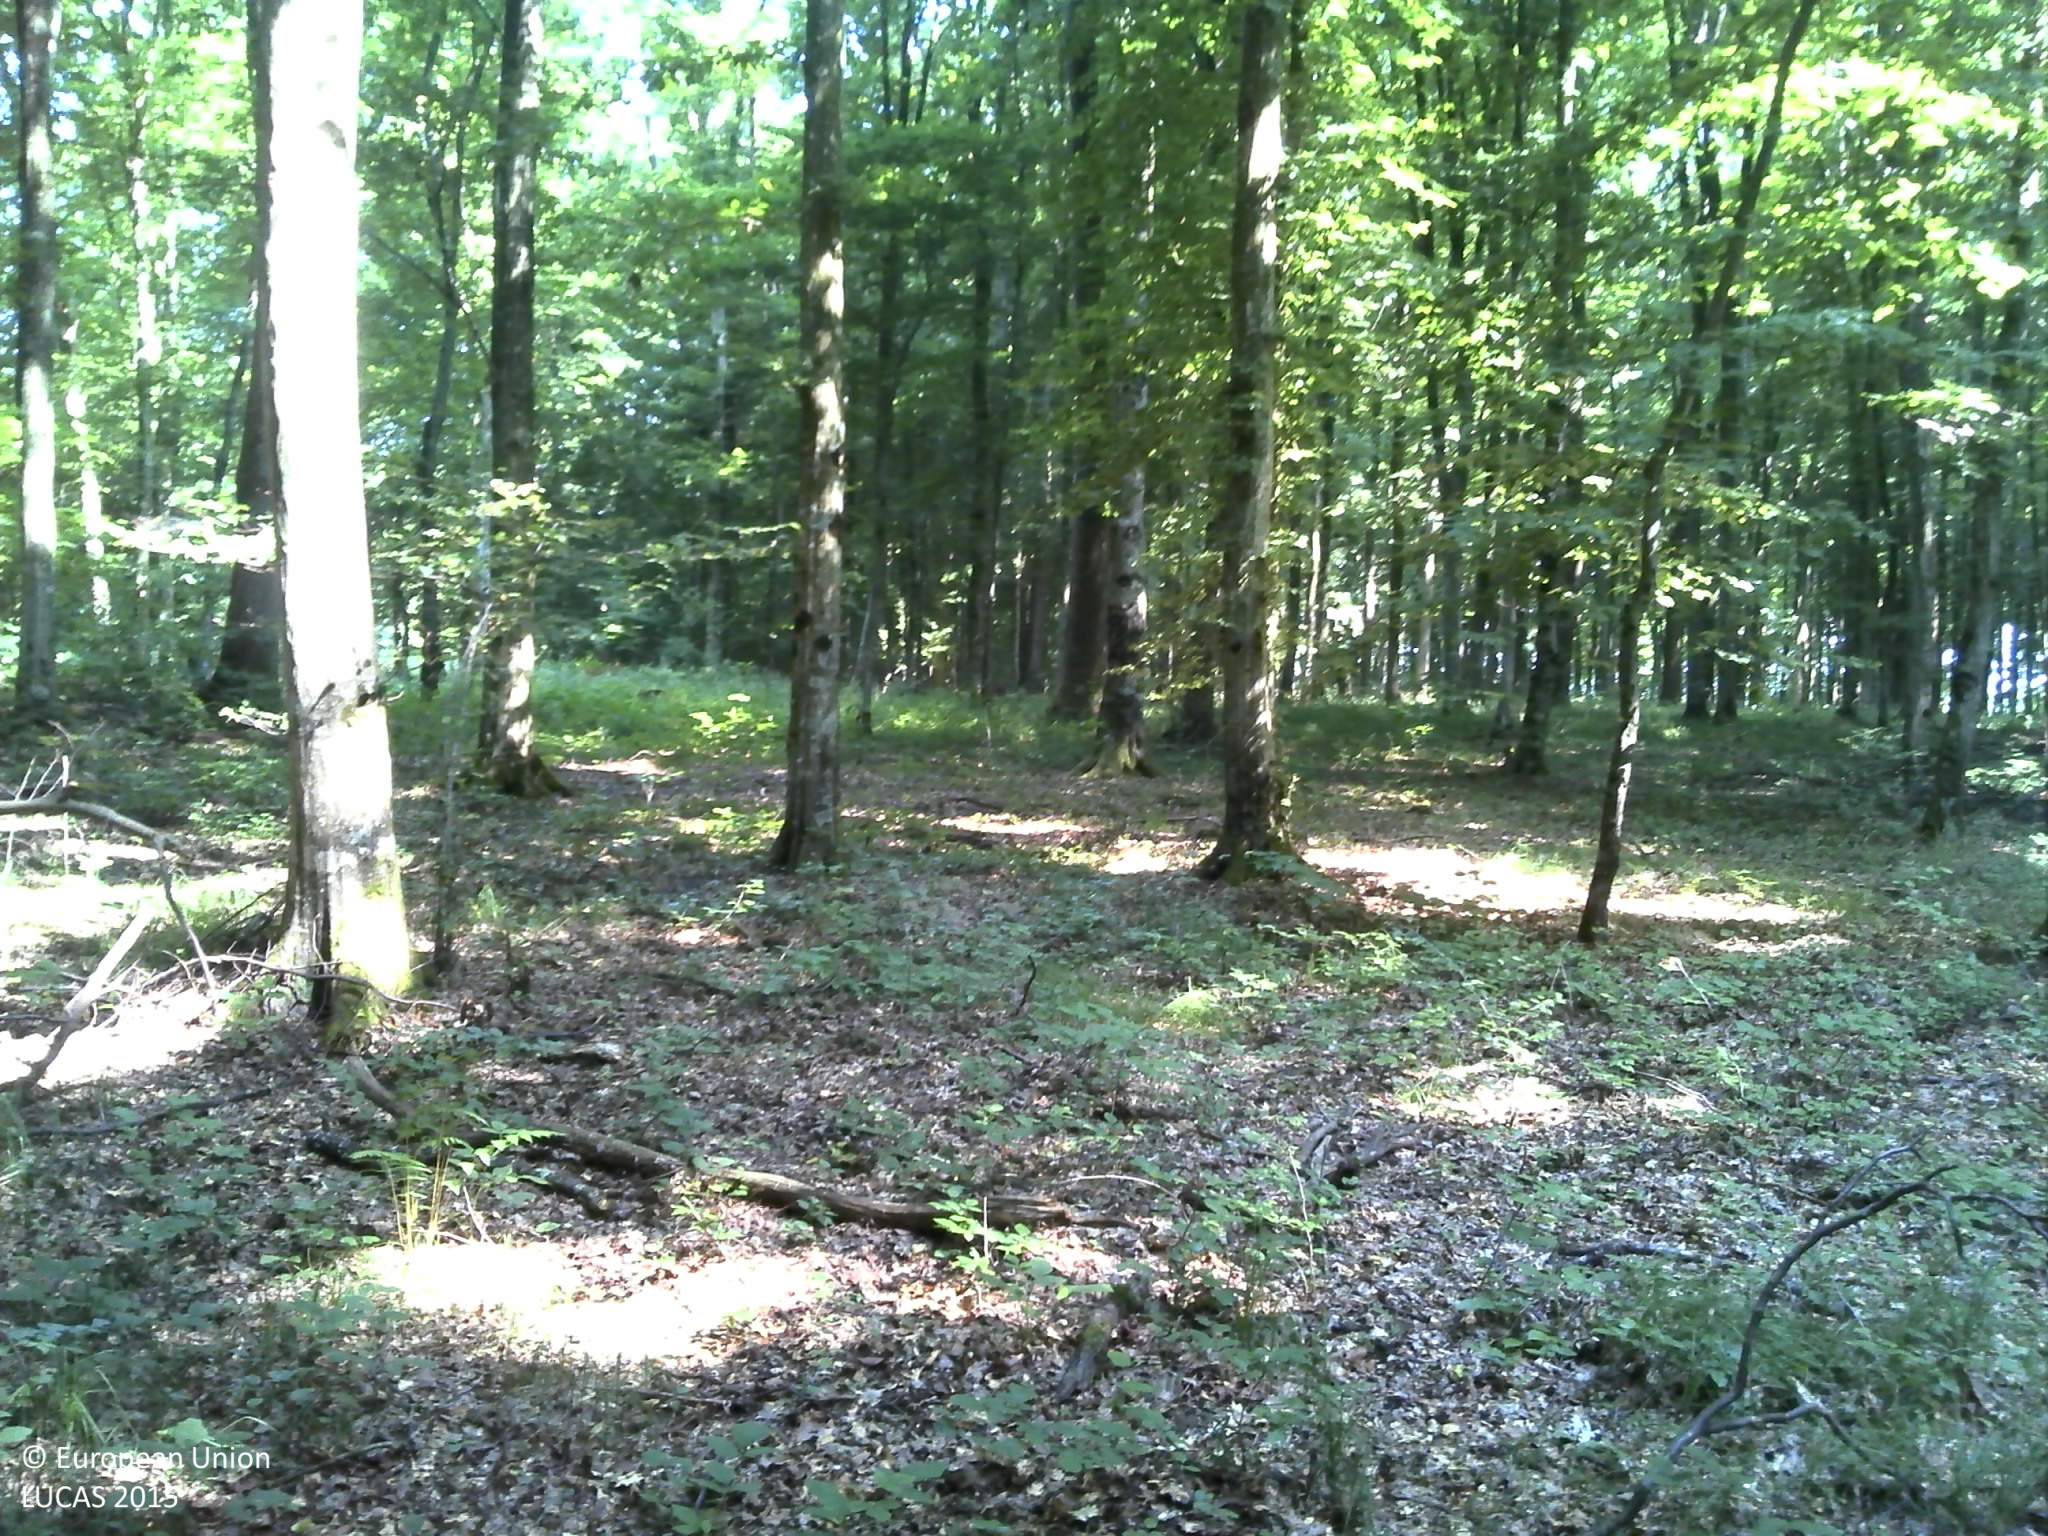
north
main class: Woodland
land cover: Broadleaved woodland
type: mesophytic deciduous forest
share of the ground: > 75 %
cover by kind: broadleaved forest trees 90 %, shrubs 5 %, herbaceous plants 5 %
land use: Forestry
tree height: > 5 m
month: July
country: HR
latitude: 45.7908
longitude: 16.5212
